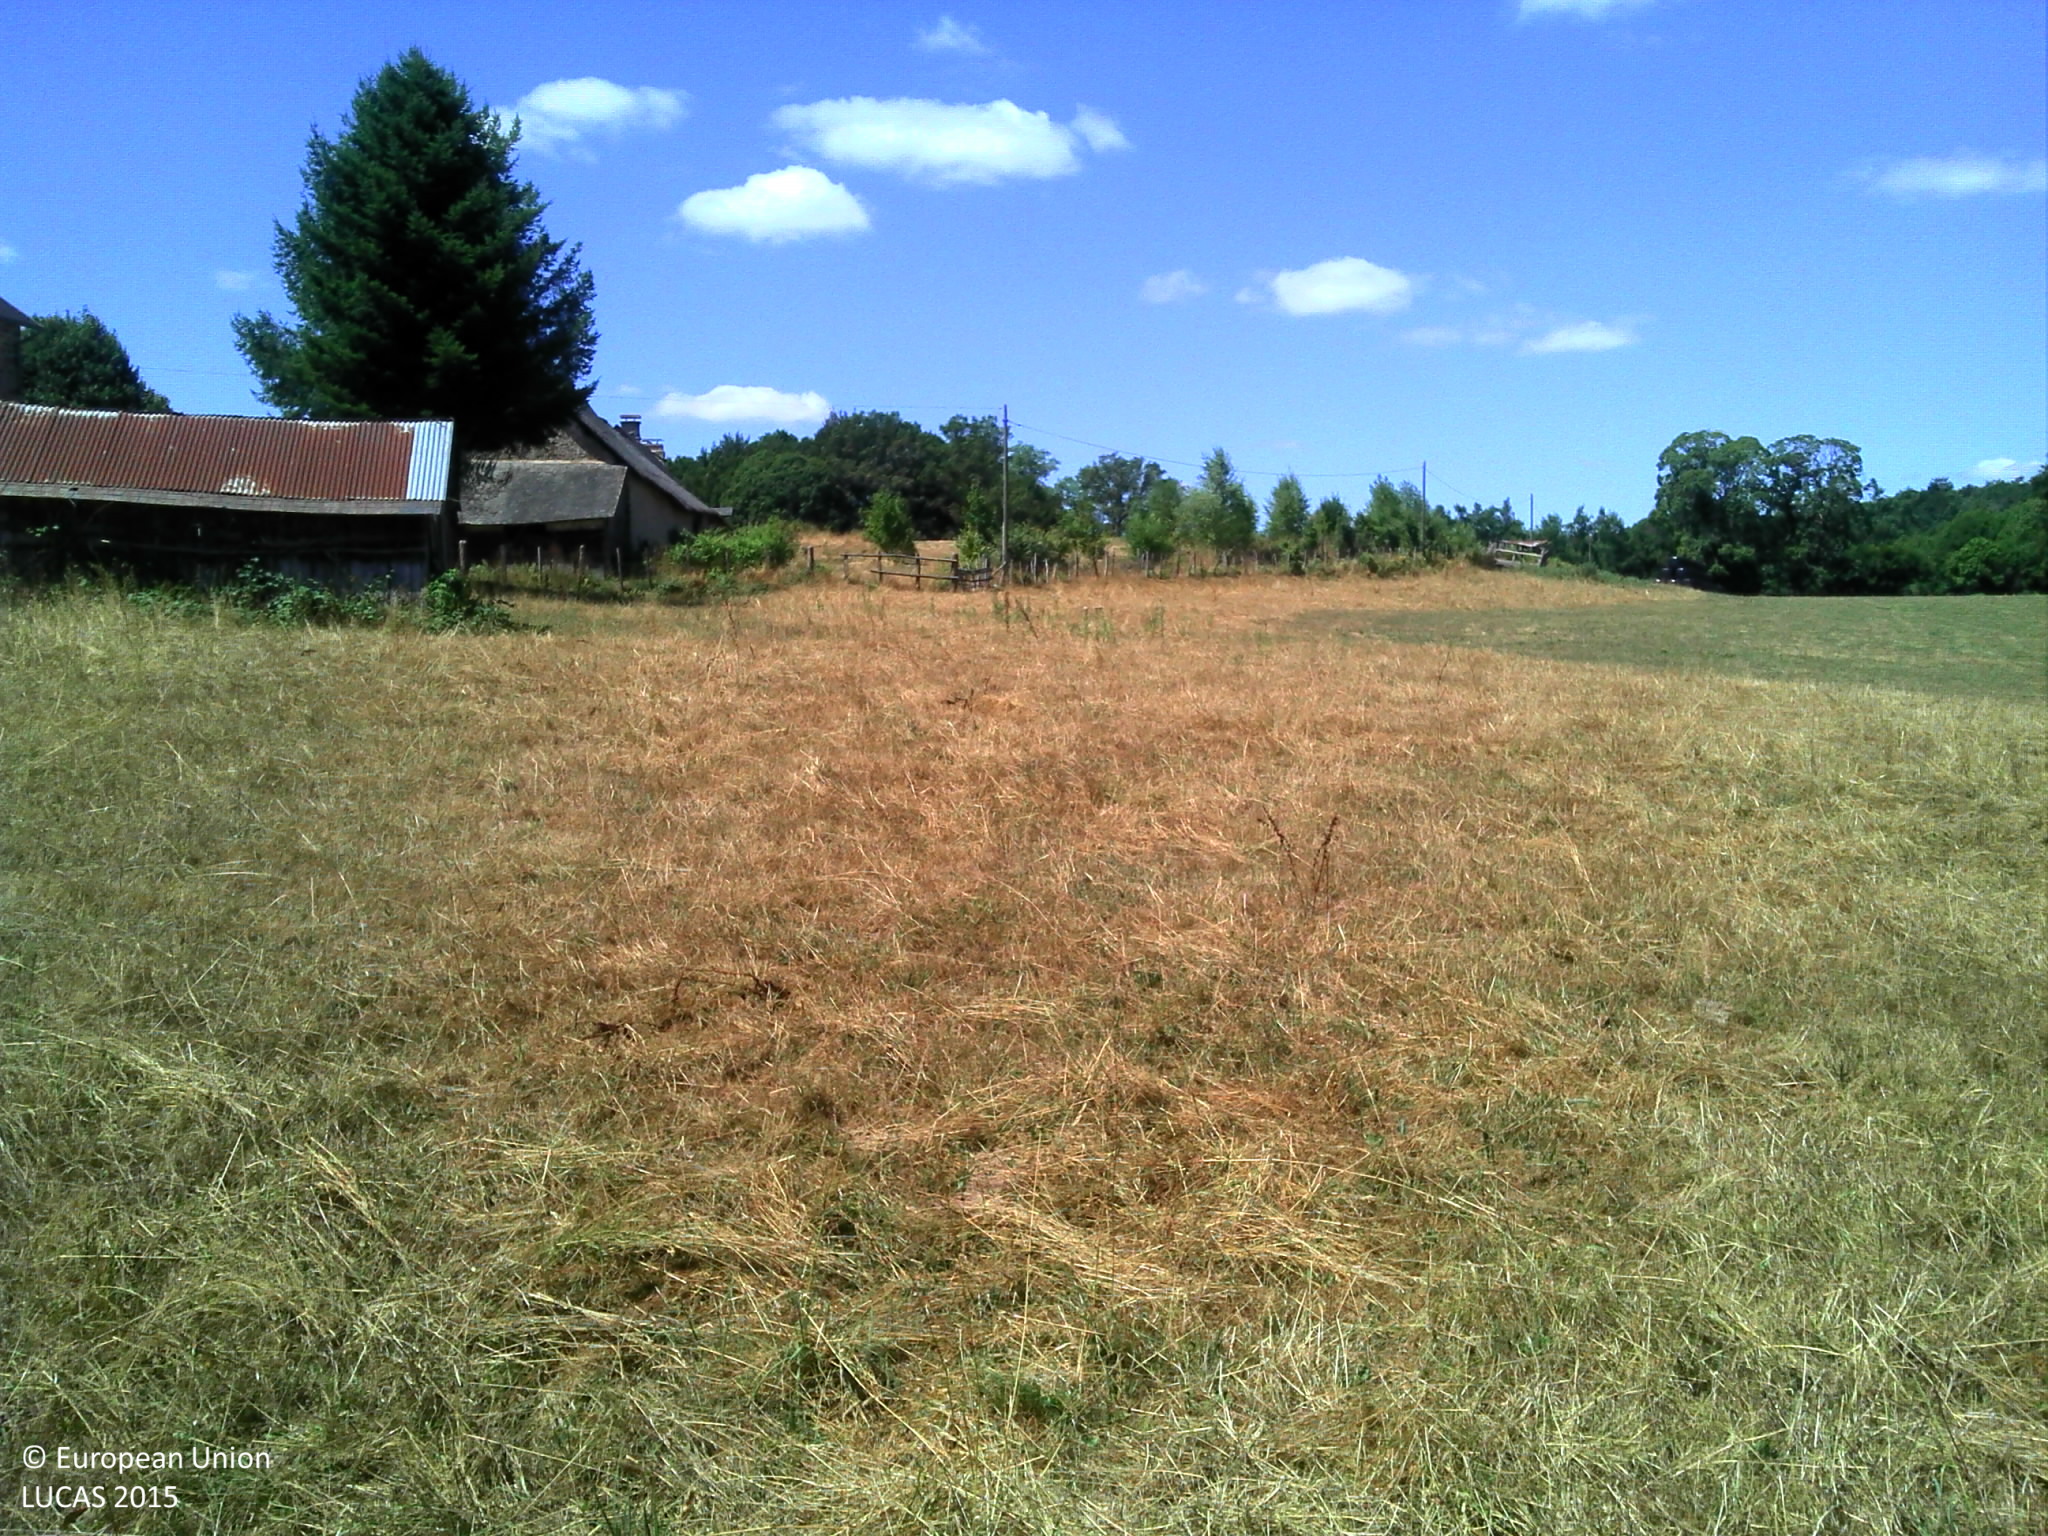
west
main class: Grassland
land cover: Grassland without tree/shrub cover
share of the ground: > 75 %
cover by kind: herbaceous plants 100 %
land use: Agriculture (excluding fallow land and kitchen gardens)
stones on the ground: < 10 %
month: July
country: FR
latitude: 45.5718
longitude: 1.6523
